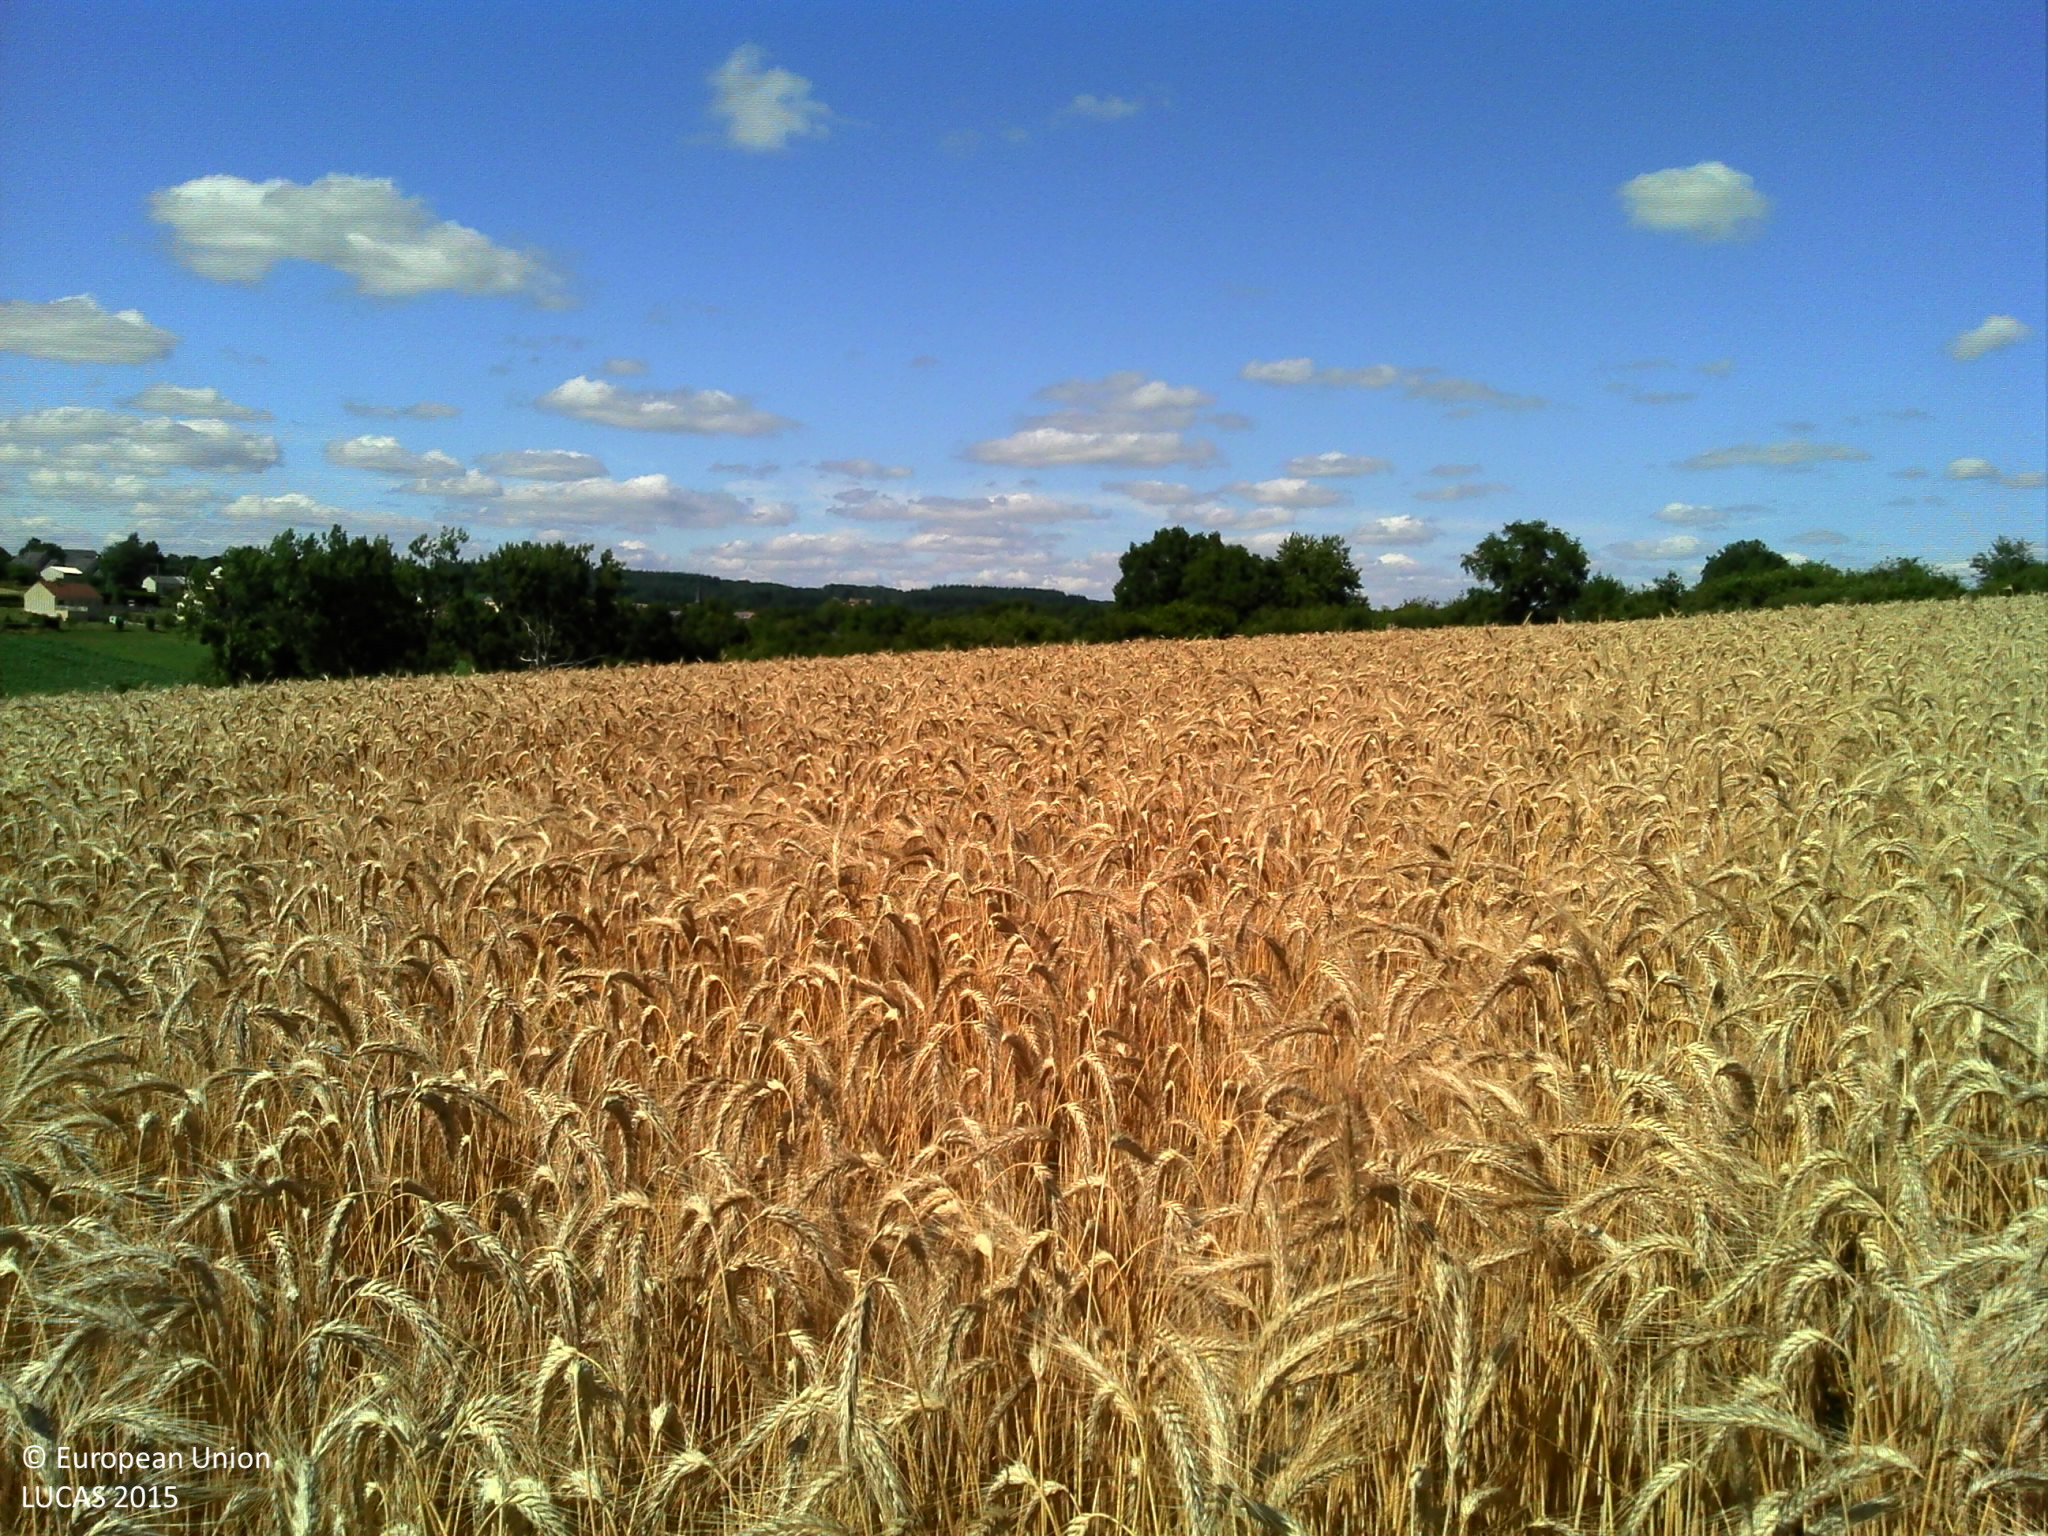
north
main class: Cropland
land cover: Common wheat
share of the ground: > 75 %
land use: Agriculture (excluding fallow land and kitchen gardens)
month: July
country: FR
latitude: 48.4755
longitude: -0.1903
